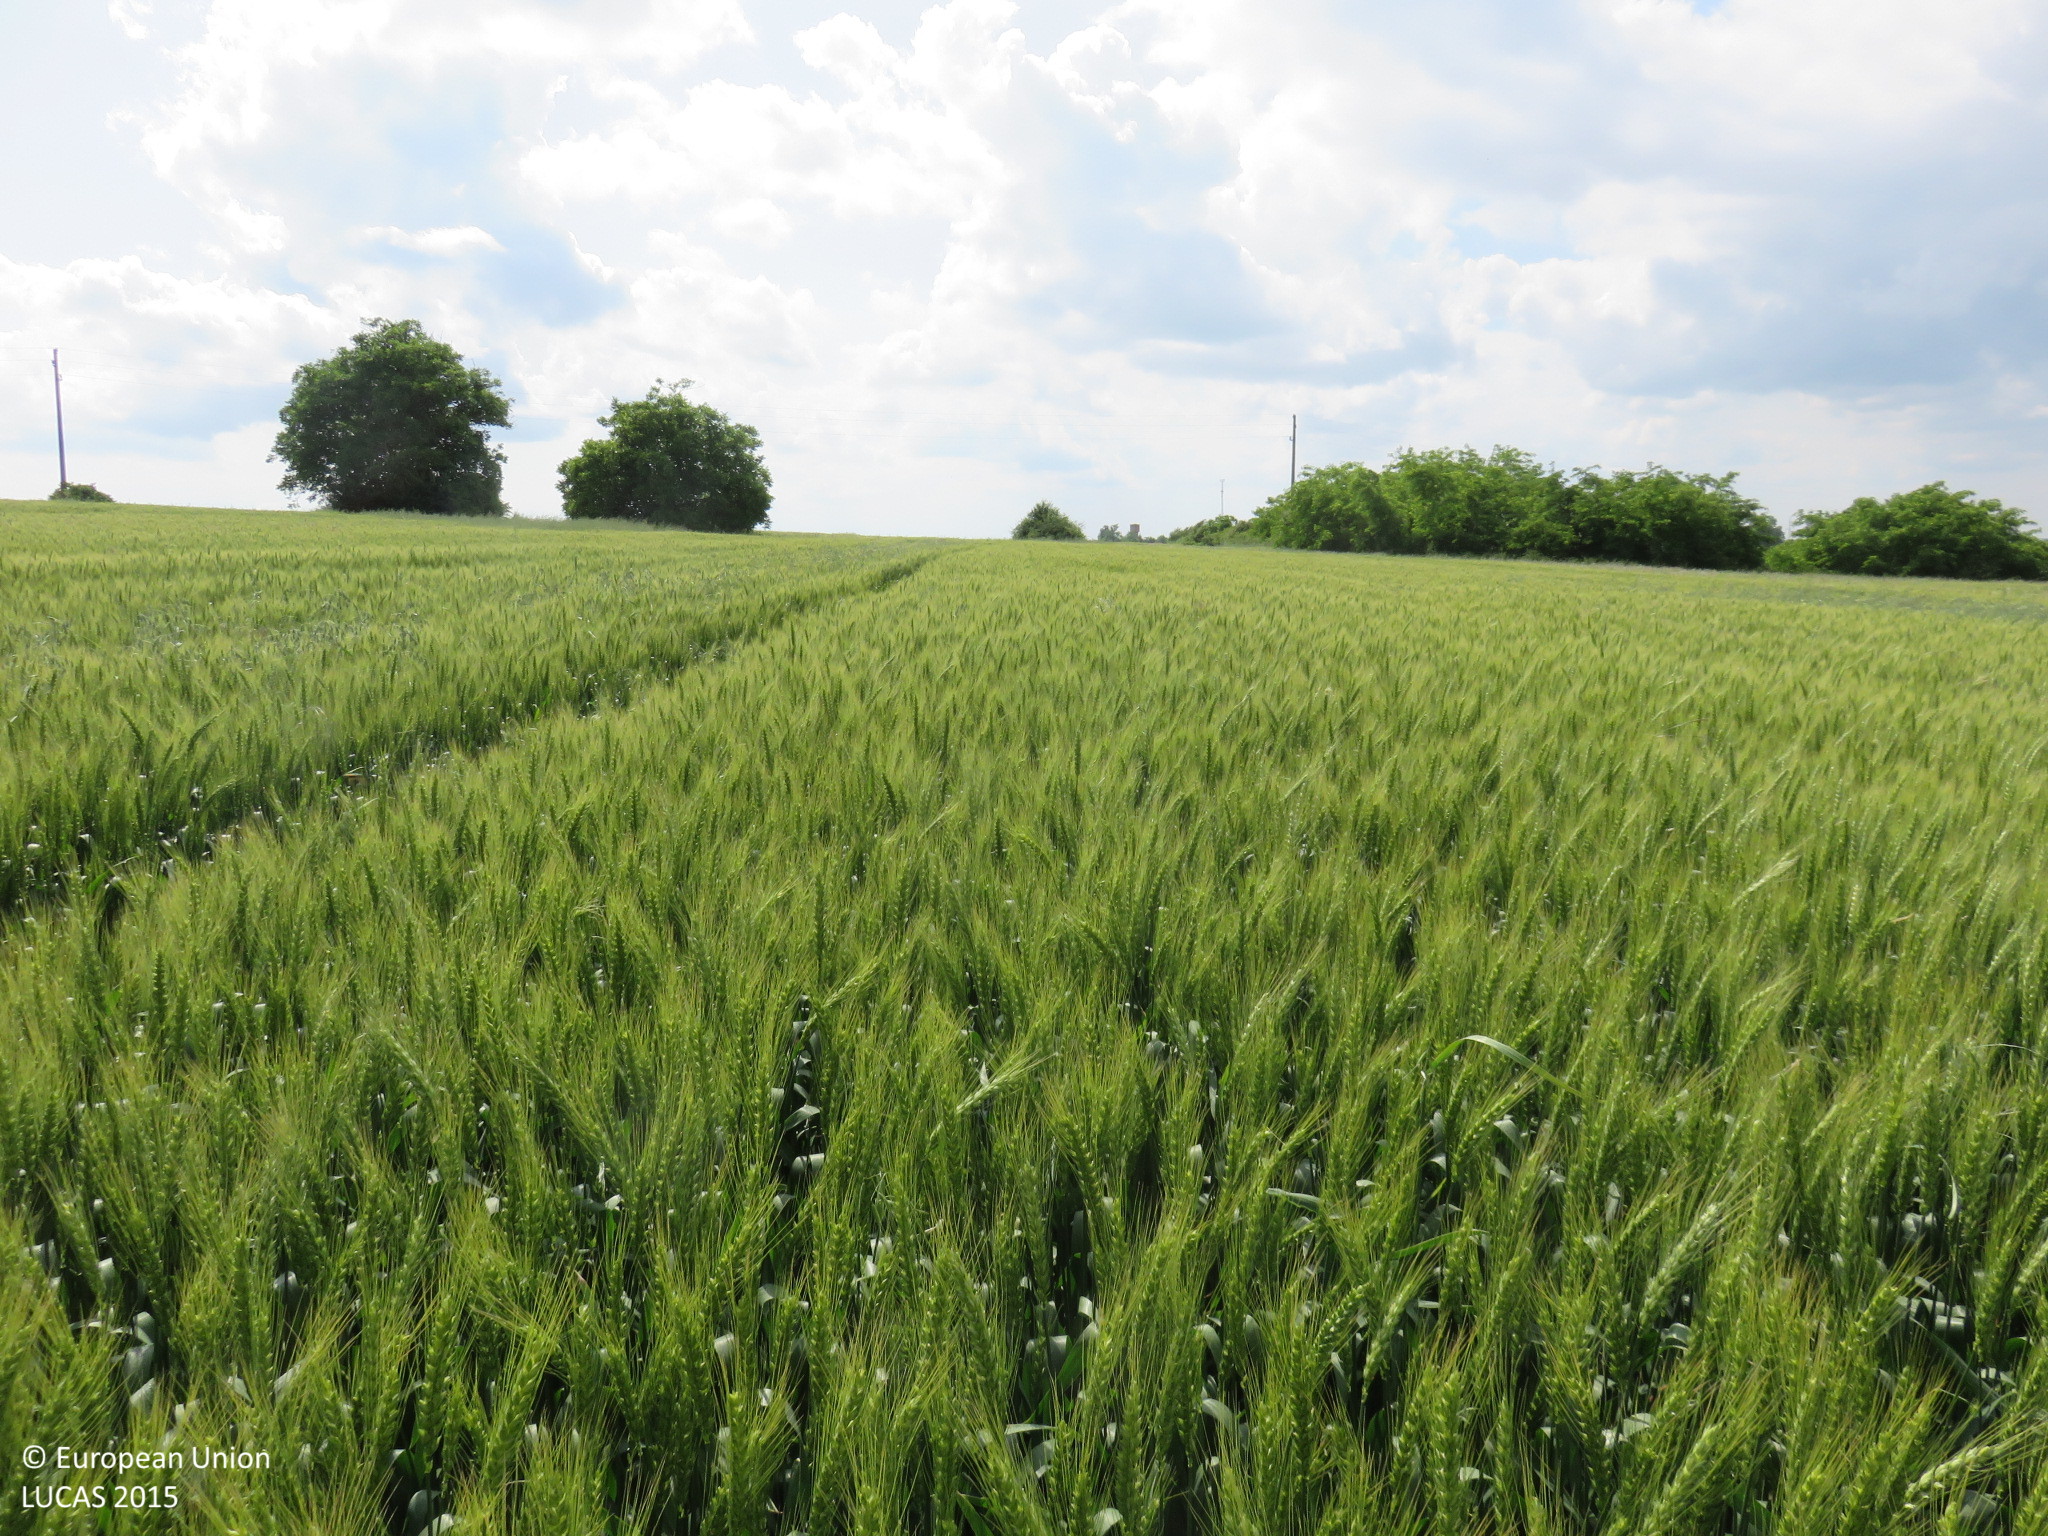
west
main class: Cropland
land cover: Common wheat
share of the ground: > 75 %
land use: Agriculture (excluding fallow land and kitchen gardens)
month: May
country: BG
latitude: 43.3859
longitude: 24.5913
